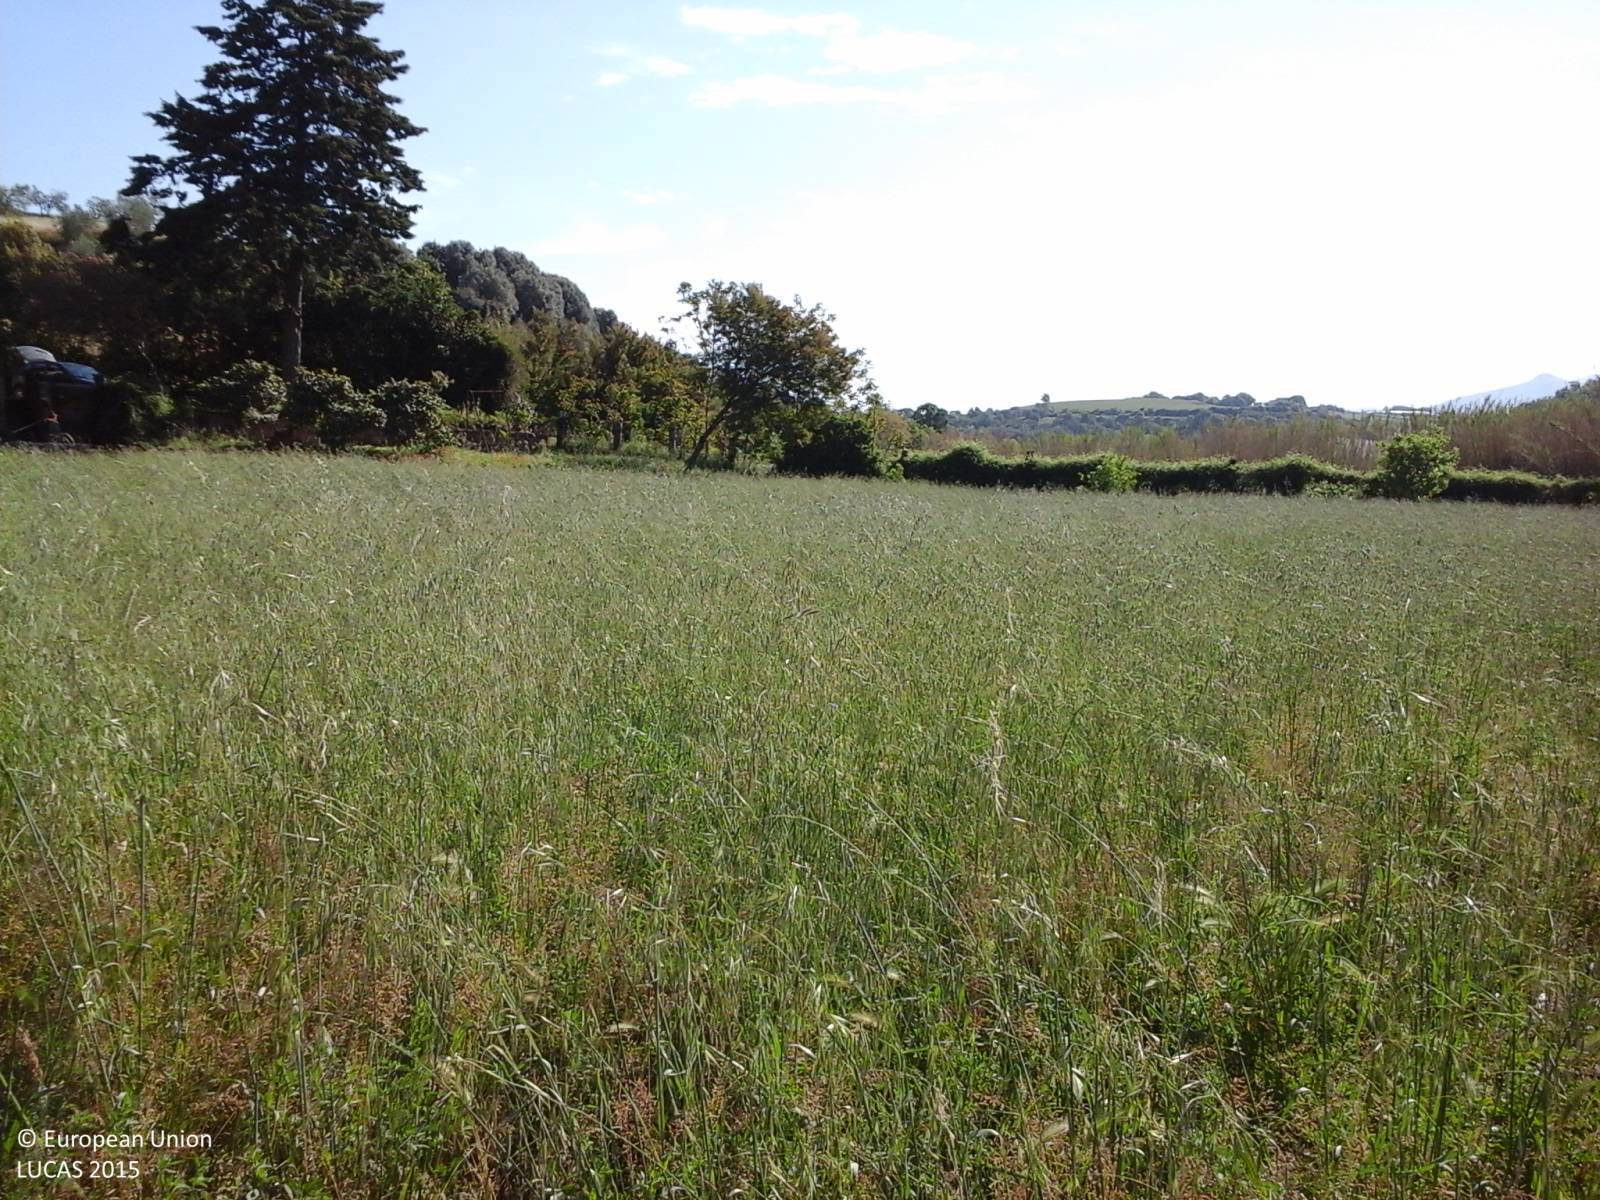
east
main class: Cropland
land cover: Oats
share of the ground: > 75 %
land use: Agriculture (excluding fallow land and kitchen gardens)
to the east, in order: Oats; Shrubland with sparse tree cover; Fences; Lucerne; Shrubland without tree cover; Rivers and streams; Shrubland without tree cover; Grass margins; Lucerne
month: May
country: IT
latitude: 42.3985
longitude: 12.0461
